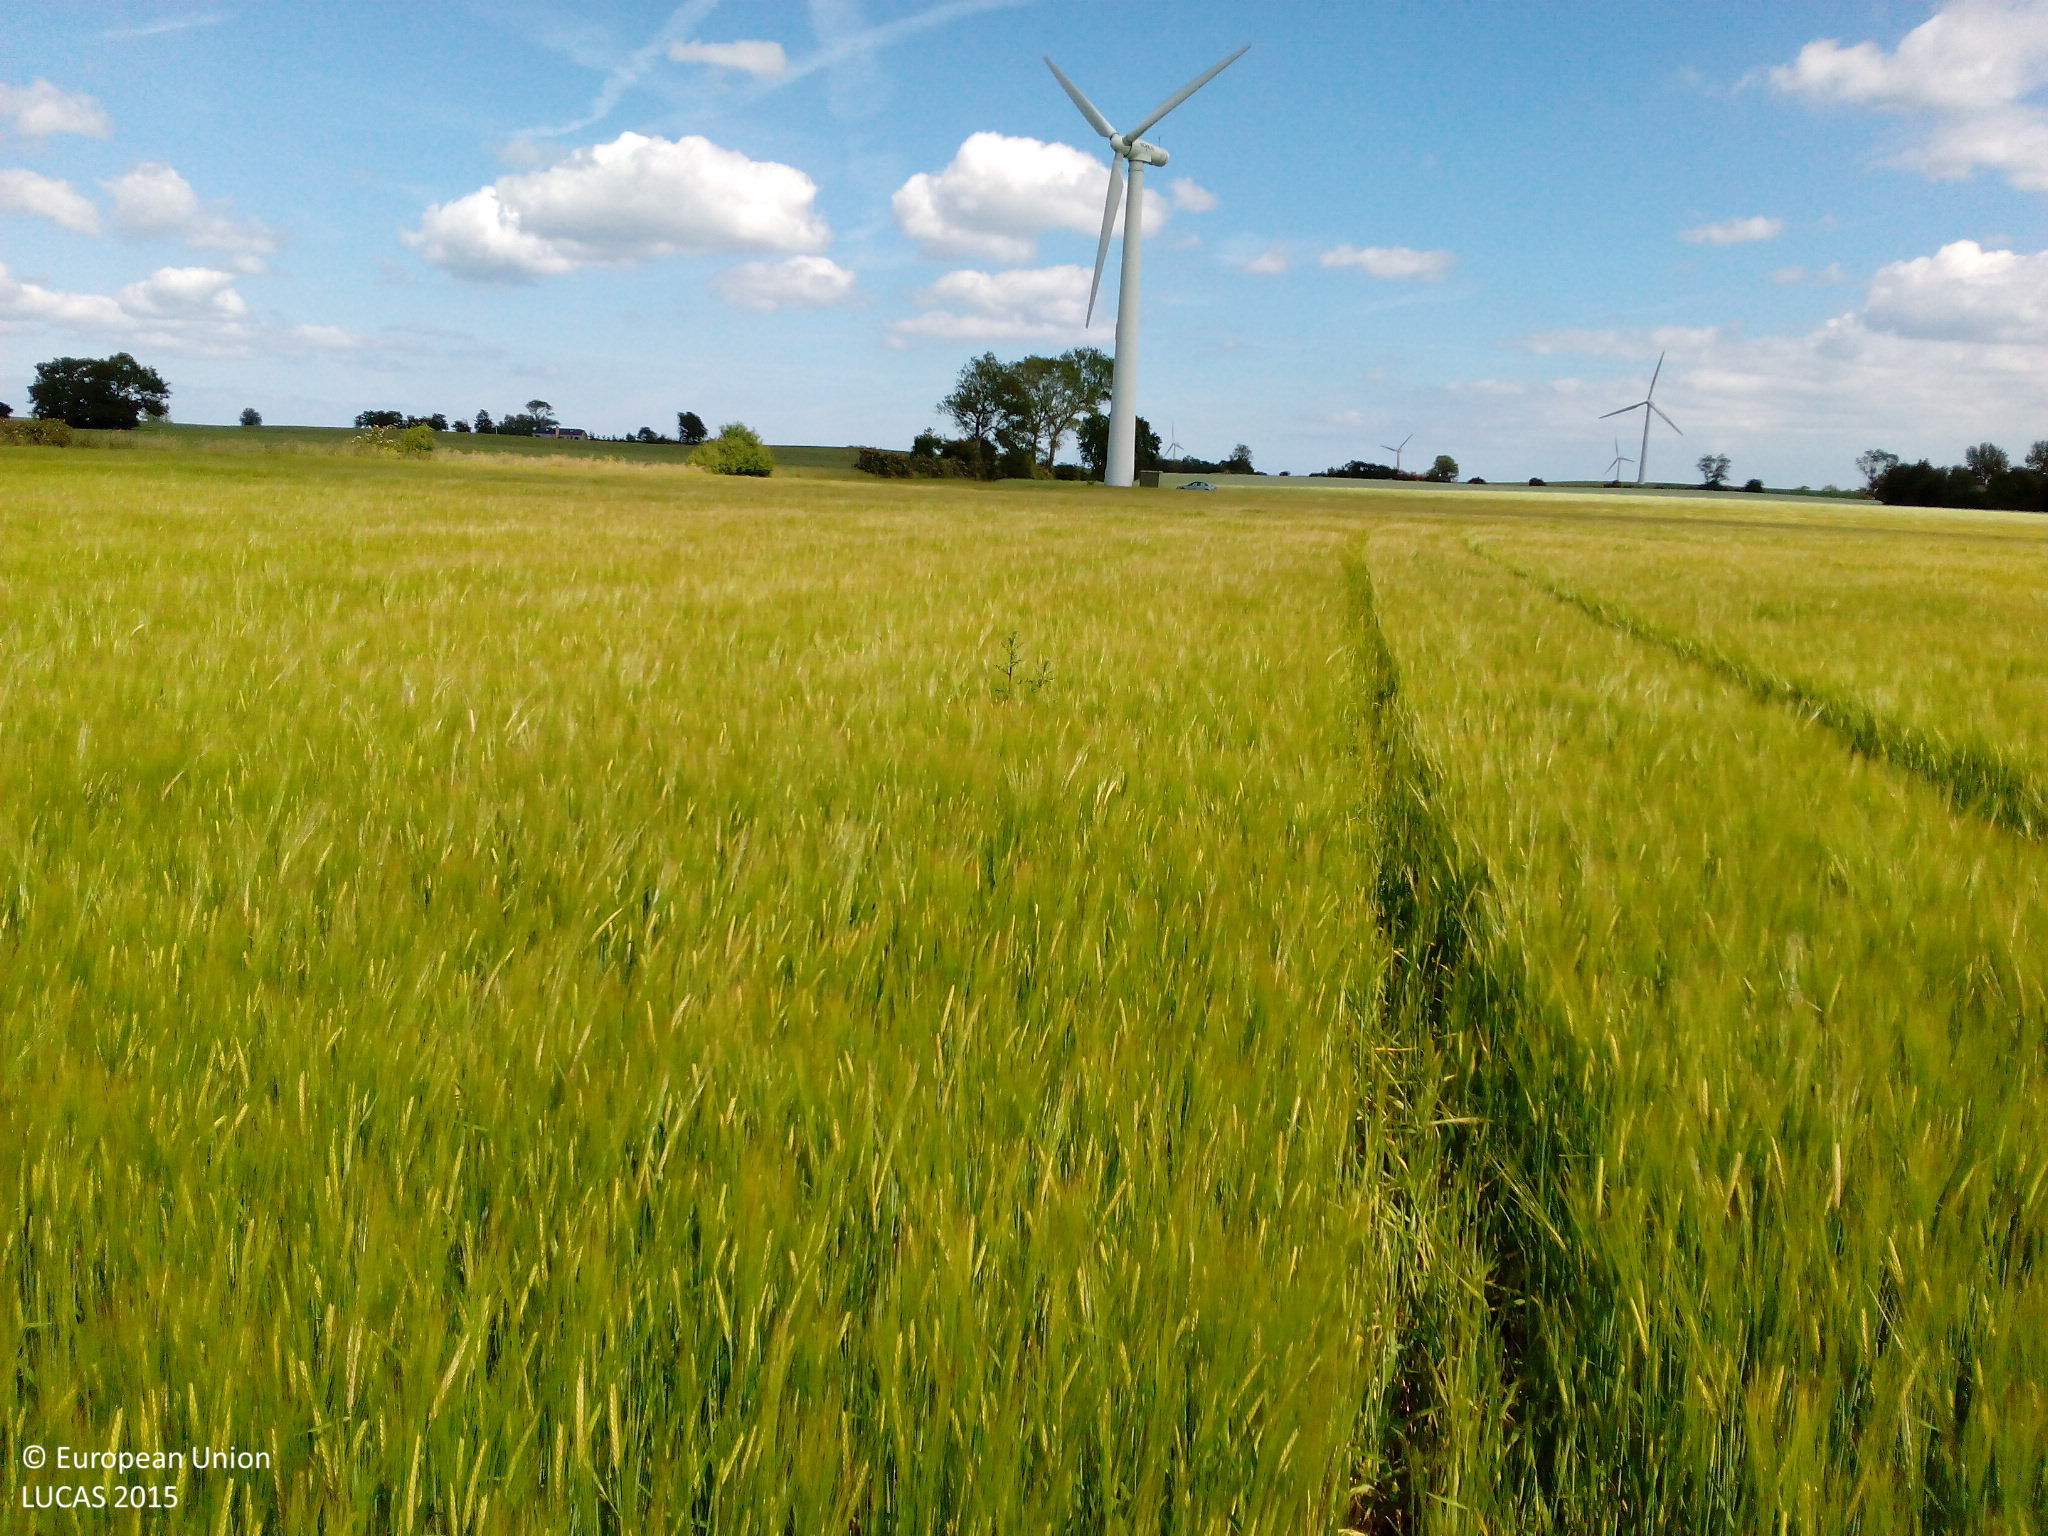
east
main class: Cropland
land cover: Barley
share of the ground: > 75 %
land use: Agriculture (excluding fallow land and kitchen gardens)
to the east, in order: Barley; Artificial constructions in urban areas; Dry pulses
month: June
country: DK
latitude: 54.6638
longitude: 11.8748
